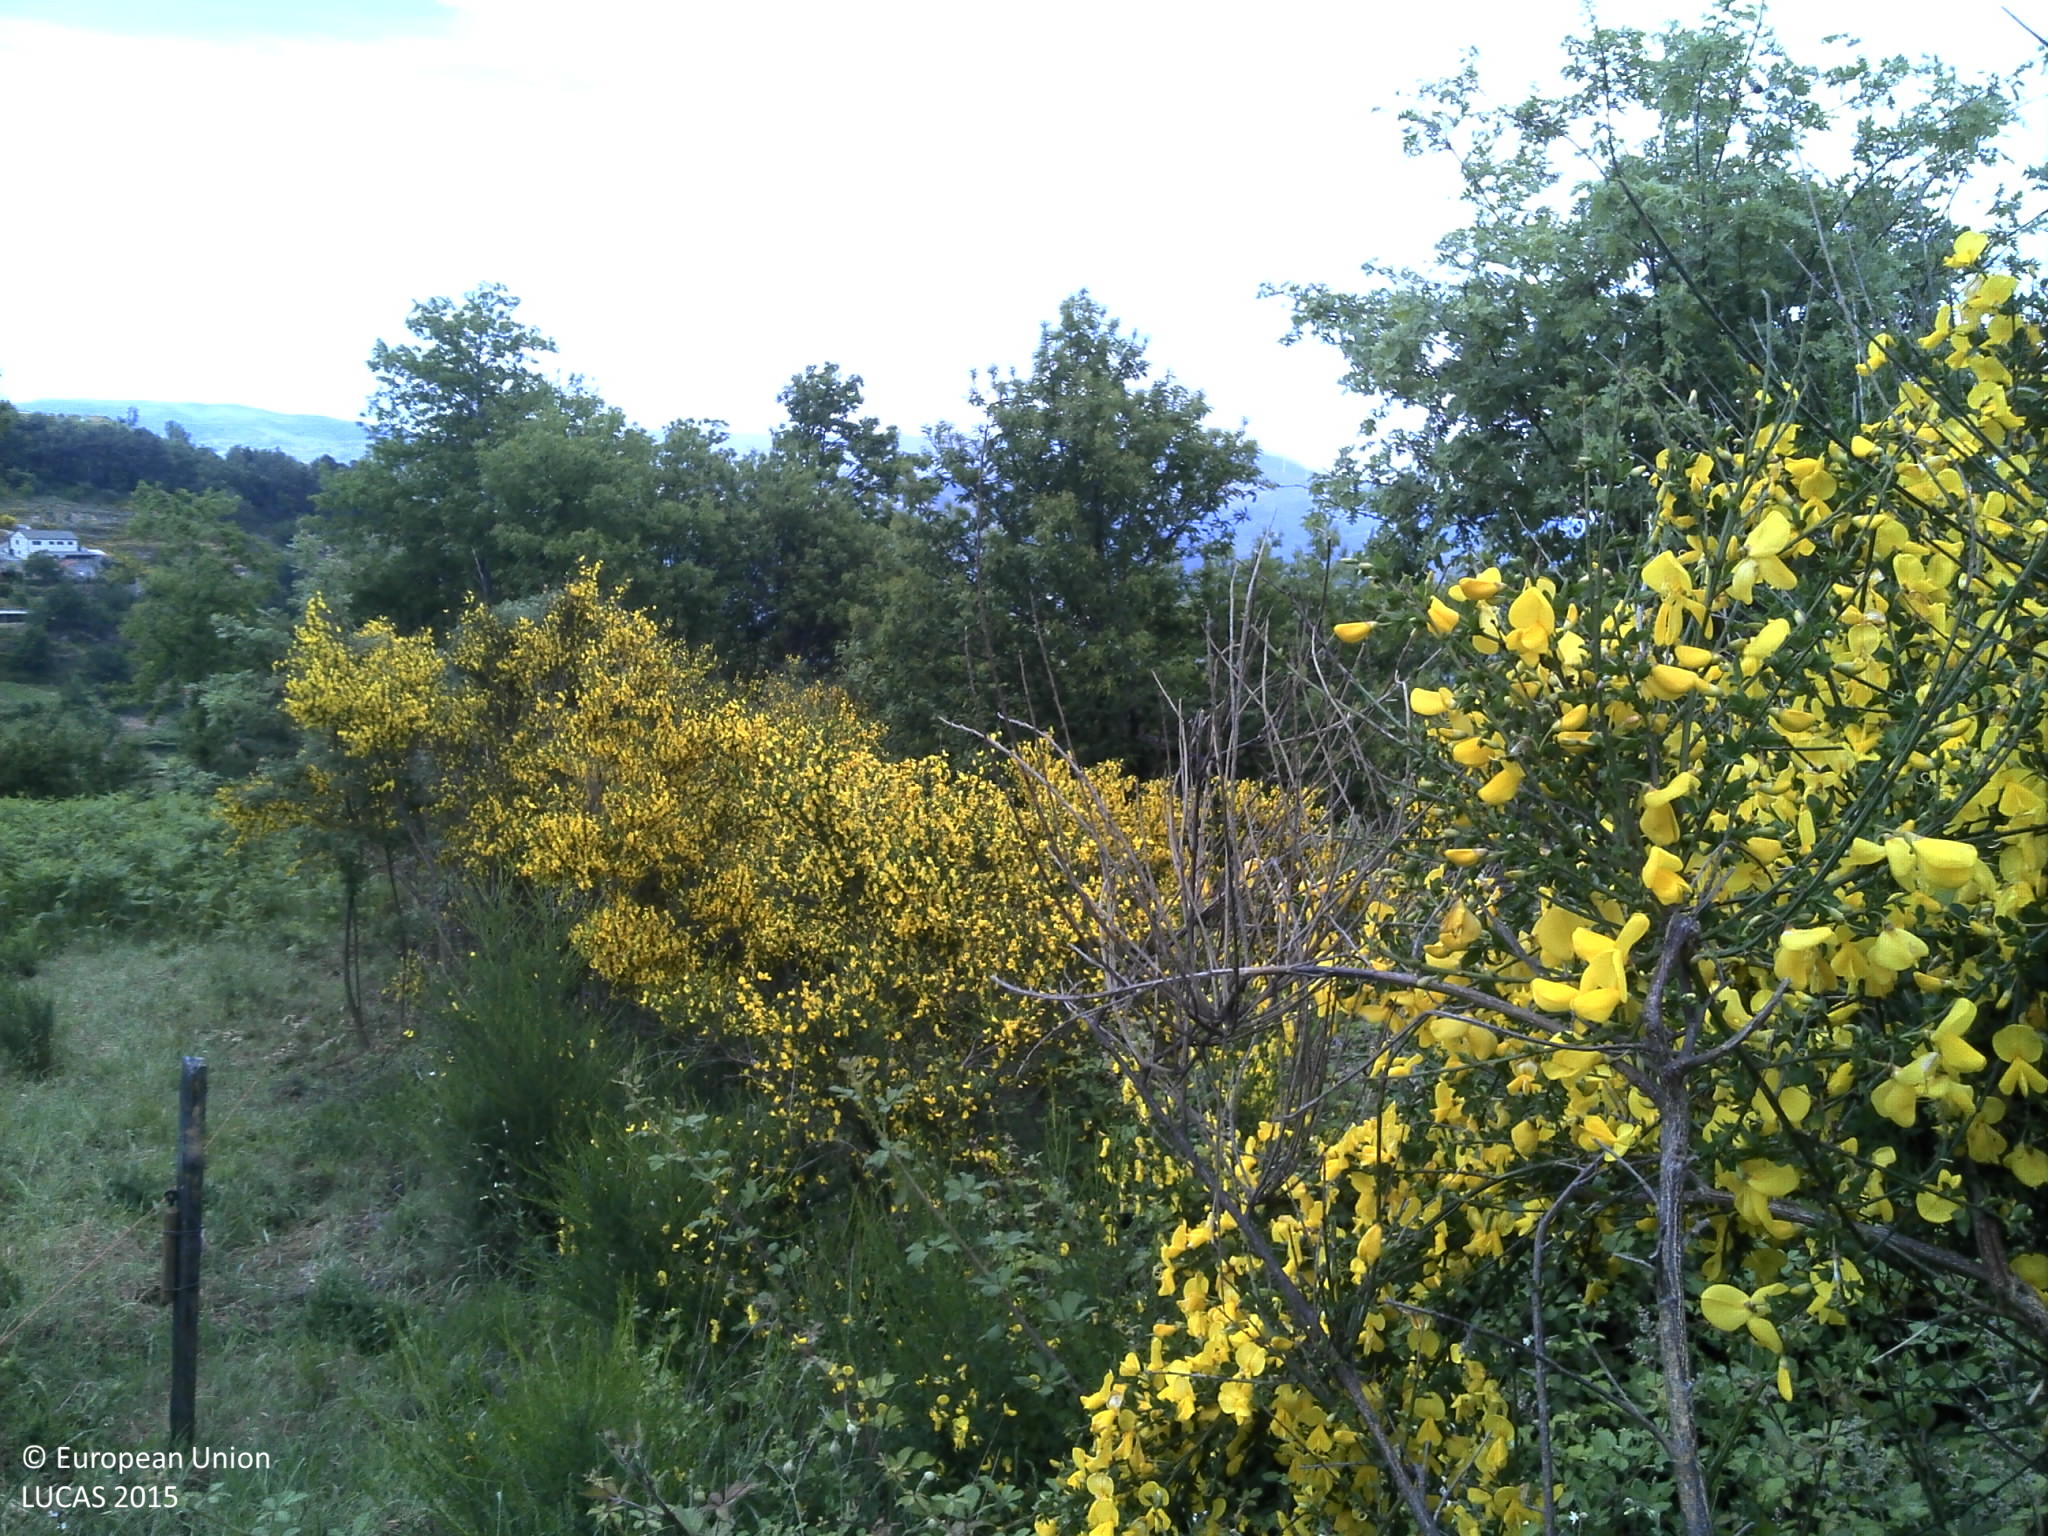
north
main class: Shrubland
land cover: Shrubland without tree cover
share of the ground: > 75 %
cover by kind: shrubs 90 %, herbaceous plants 5 %, unconsolidated bare surface 5 %
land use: Abandoned areas
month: May
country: PT
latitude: 41.0937
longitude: -7.9308
